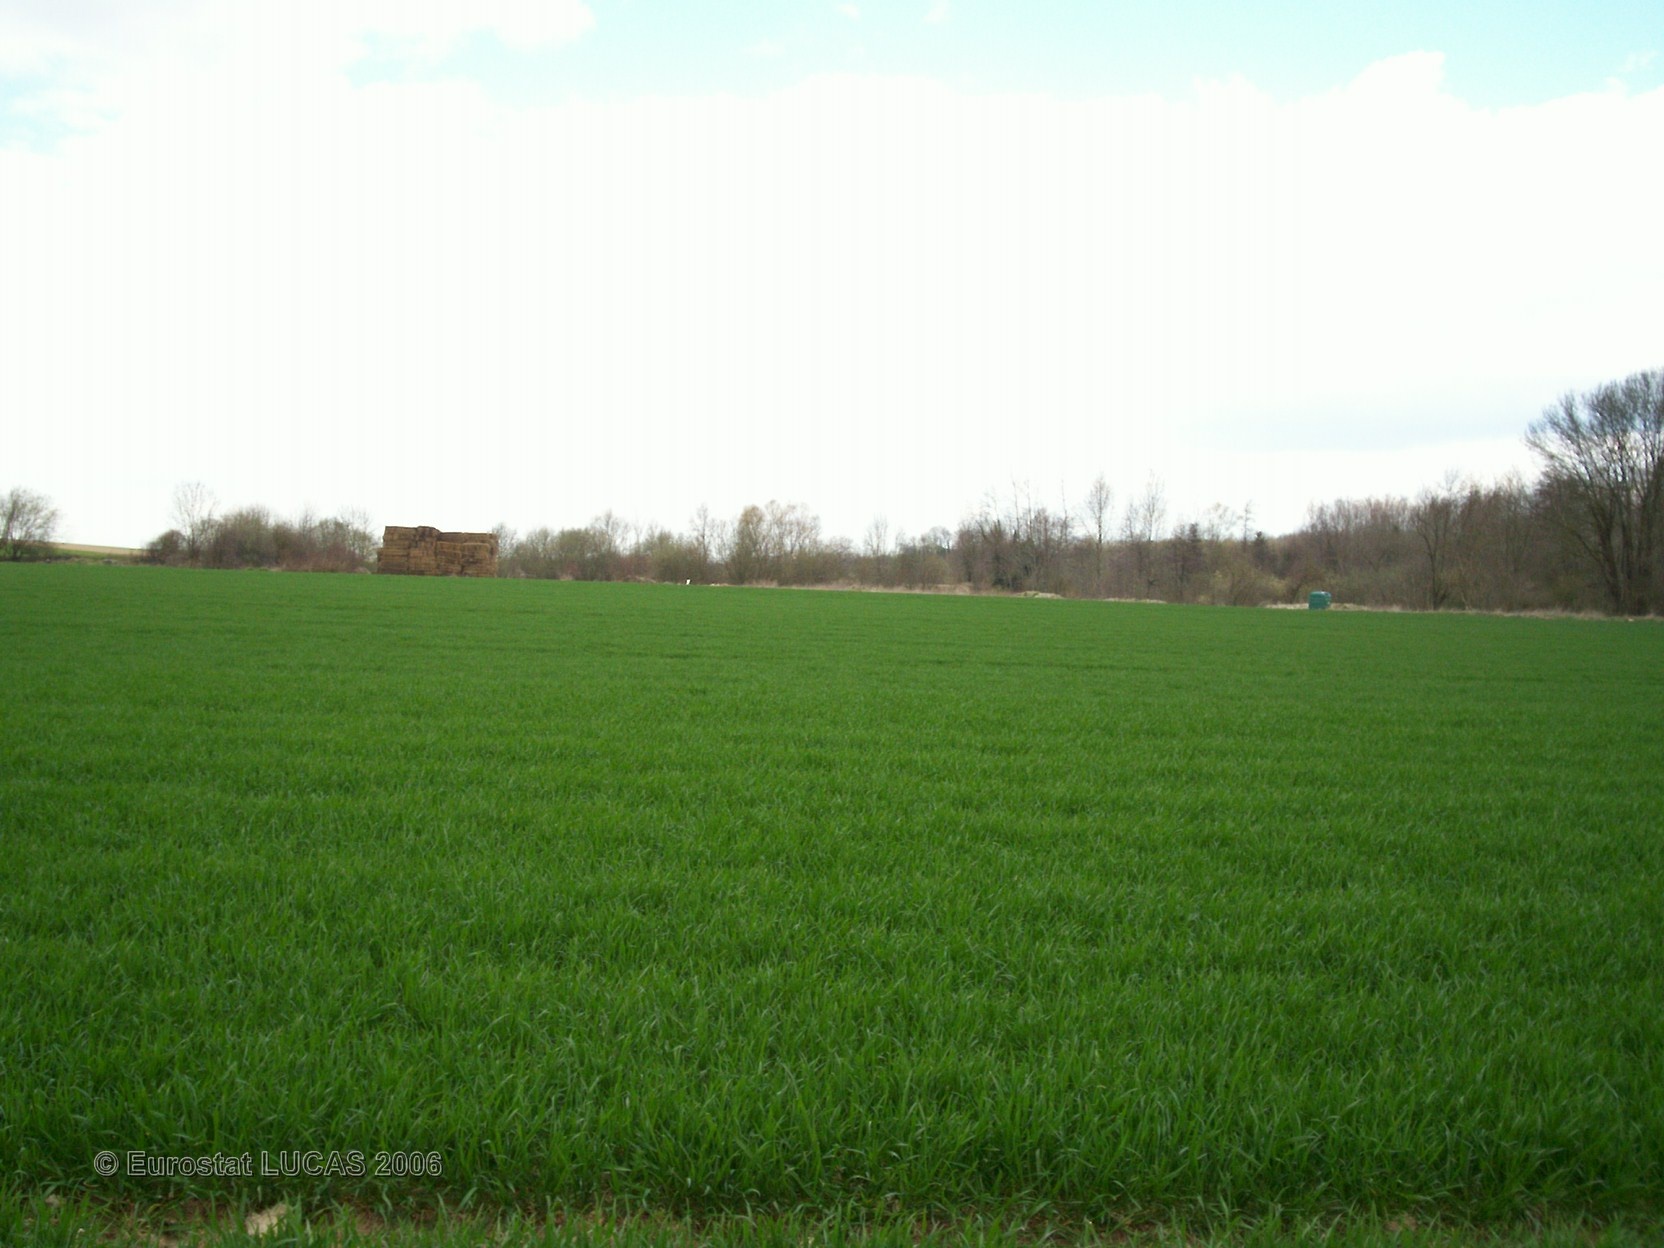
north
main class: Cropland
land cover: Common wheat
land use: Agriculture (excluding fallow land and kitchen gardens)
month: April
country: FR
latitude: 49.2357
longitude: 4.4065
